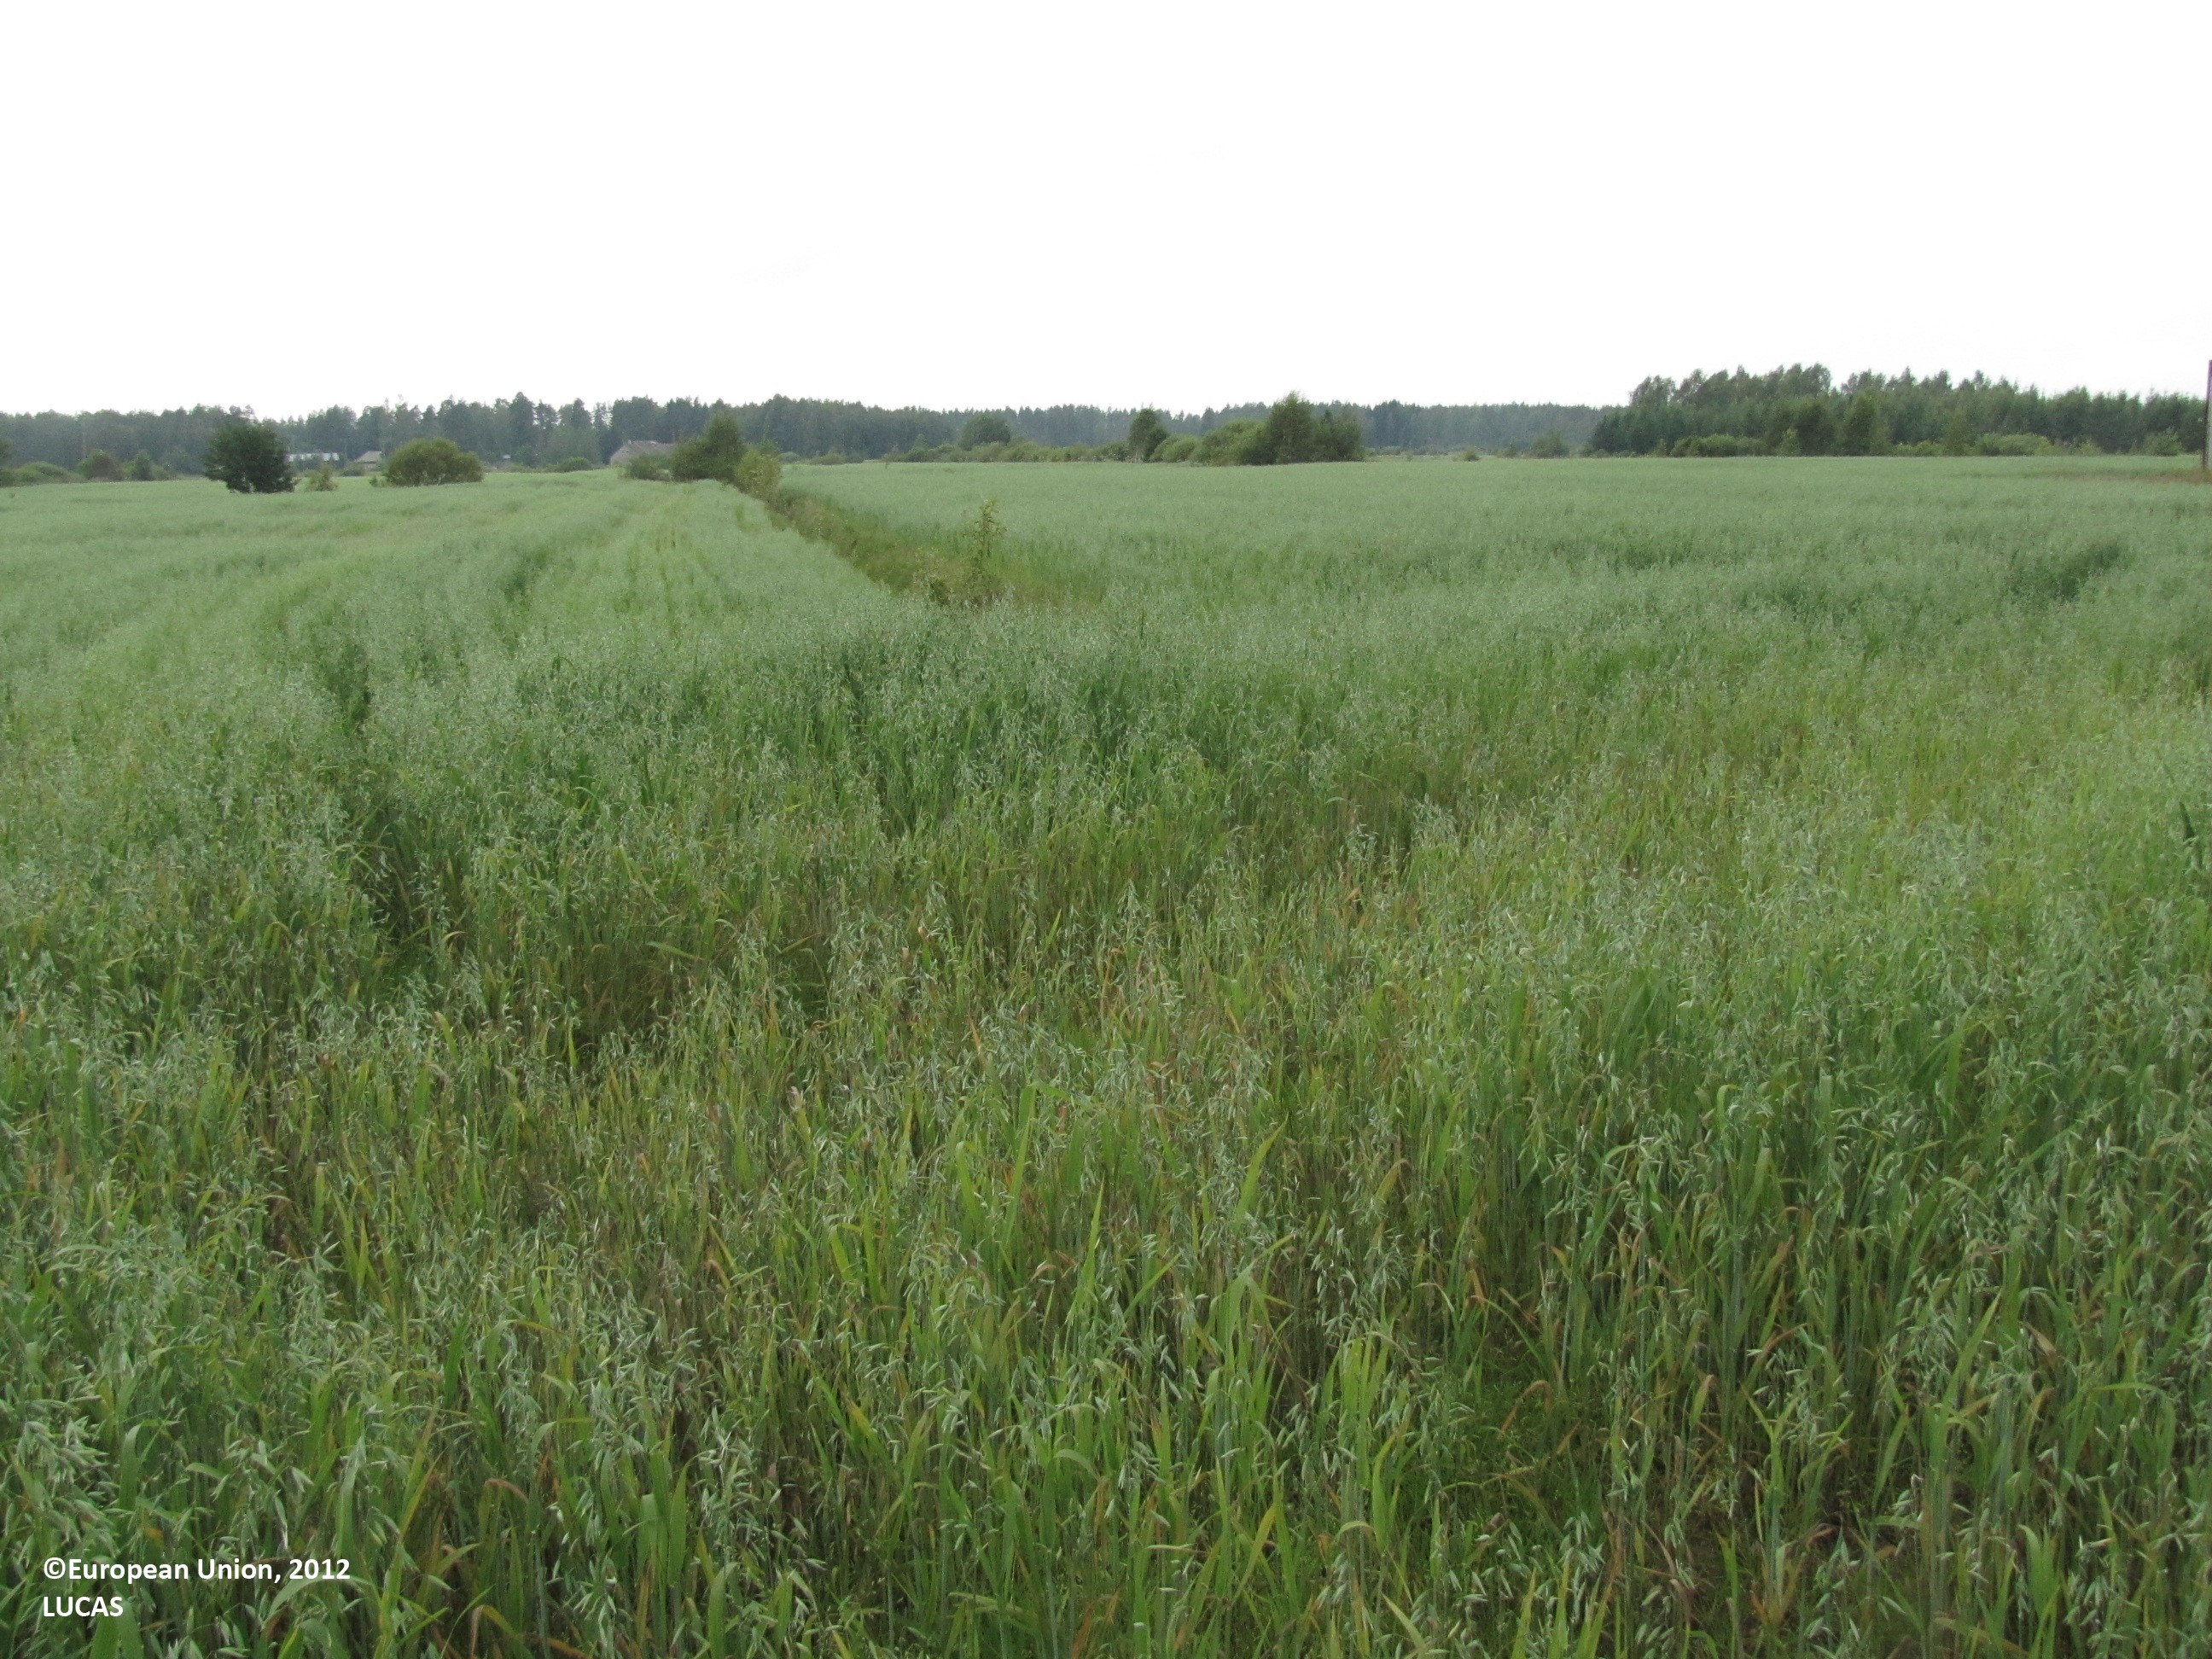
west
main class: Cropland
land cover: Oats
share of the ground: > 75 %
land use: Agriculture (excluding fallow land and kitchen gardens)
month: July
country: FI
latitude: 61.9950
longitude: 22.9526
